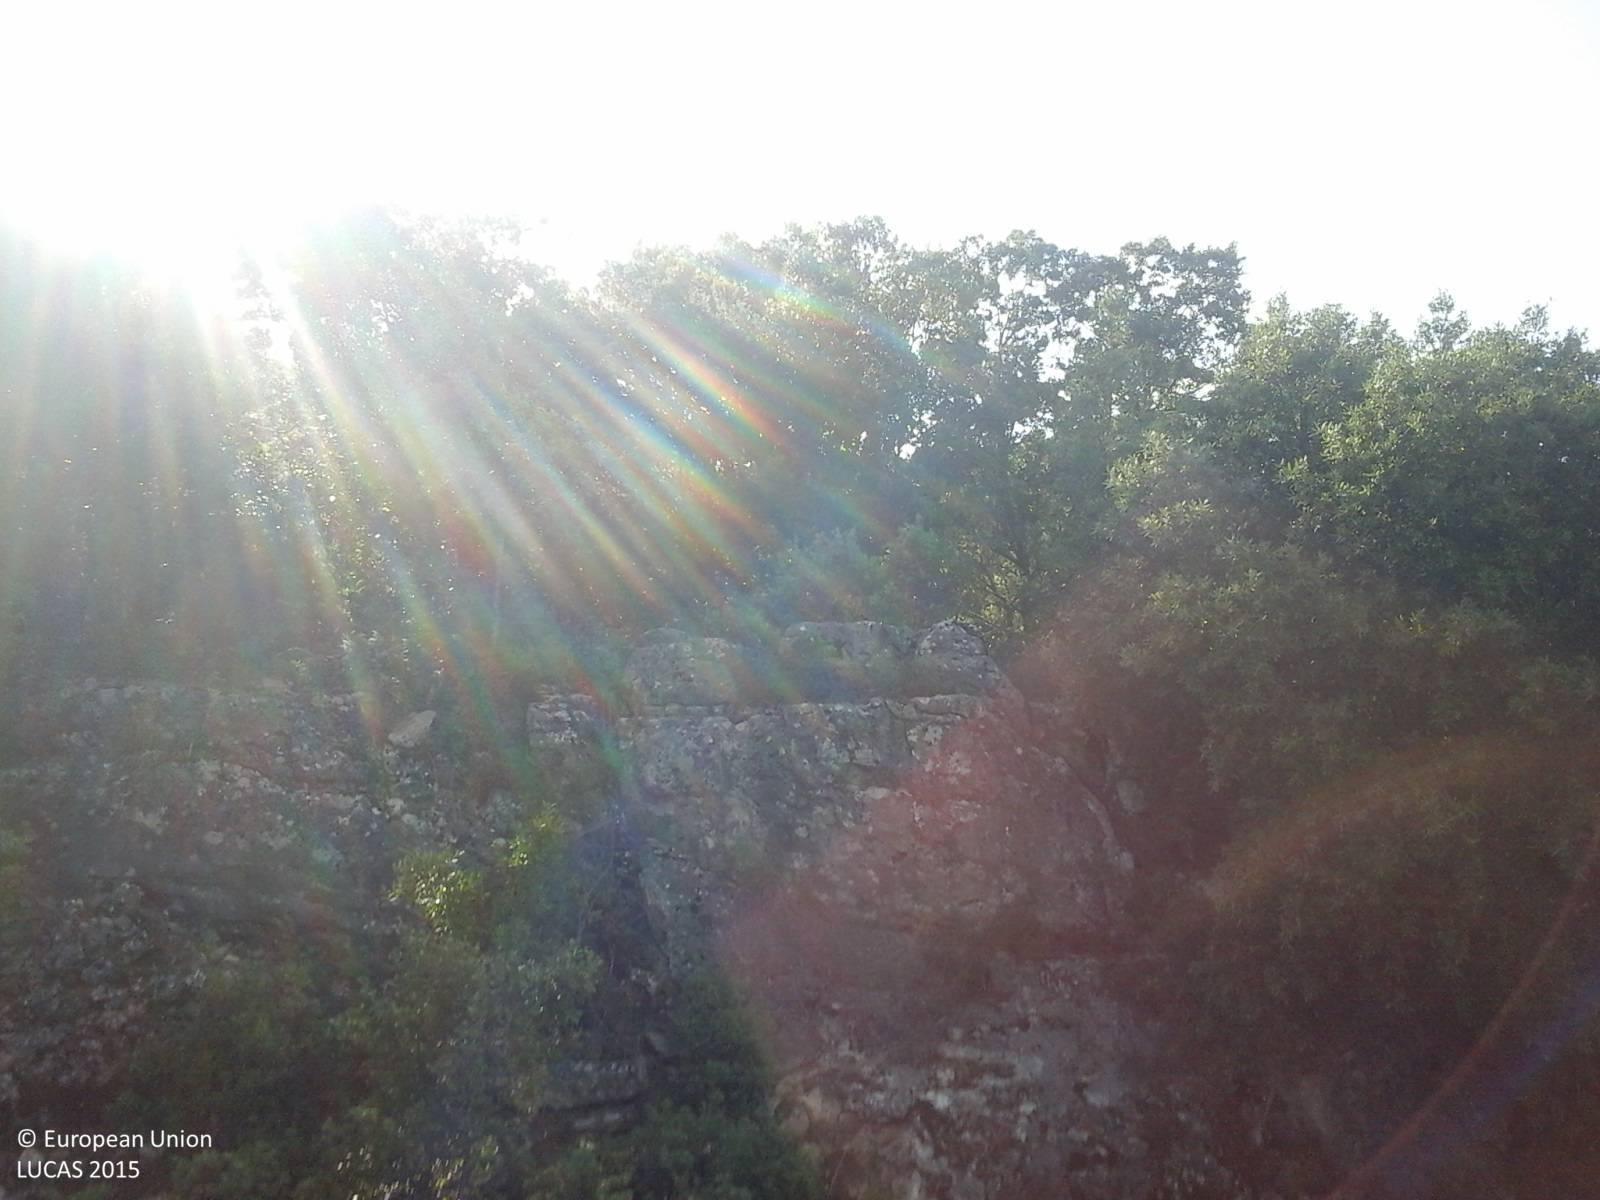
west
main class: Woodland
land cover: Pine dominated mixed woodland
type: coniferous forest of the mediterranean region
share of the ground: > 75 %
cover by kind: coniferous forest trees 50 %, broadleaved forest trees 25 %, shrubs 10 %, herbaceous plants 5 %, consolidated bare surface 5 %, unconsolidated bare surface 5 %
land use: Semi-natural and natural areas not in use
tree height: > 5 m
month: September
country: IT
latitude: 39.8314
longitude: 9.4772
